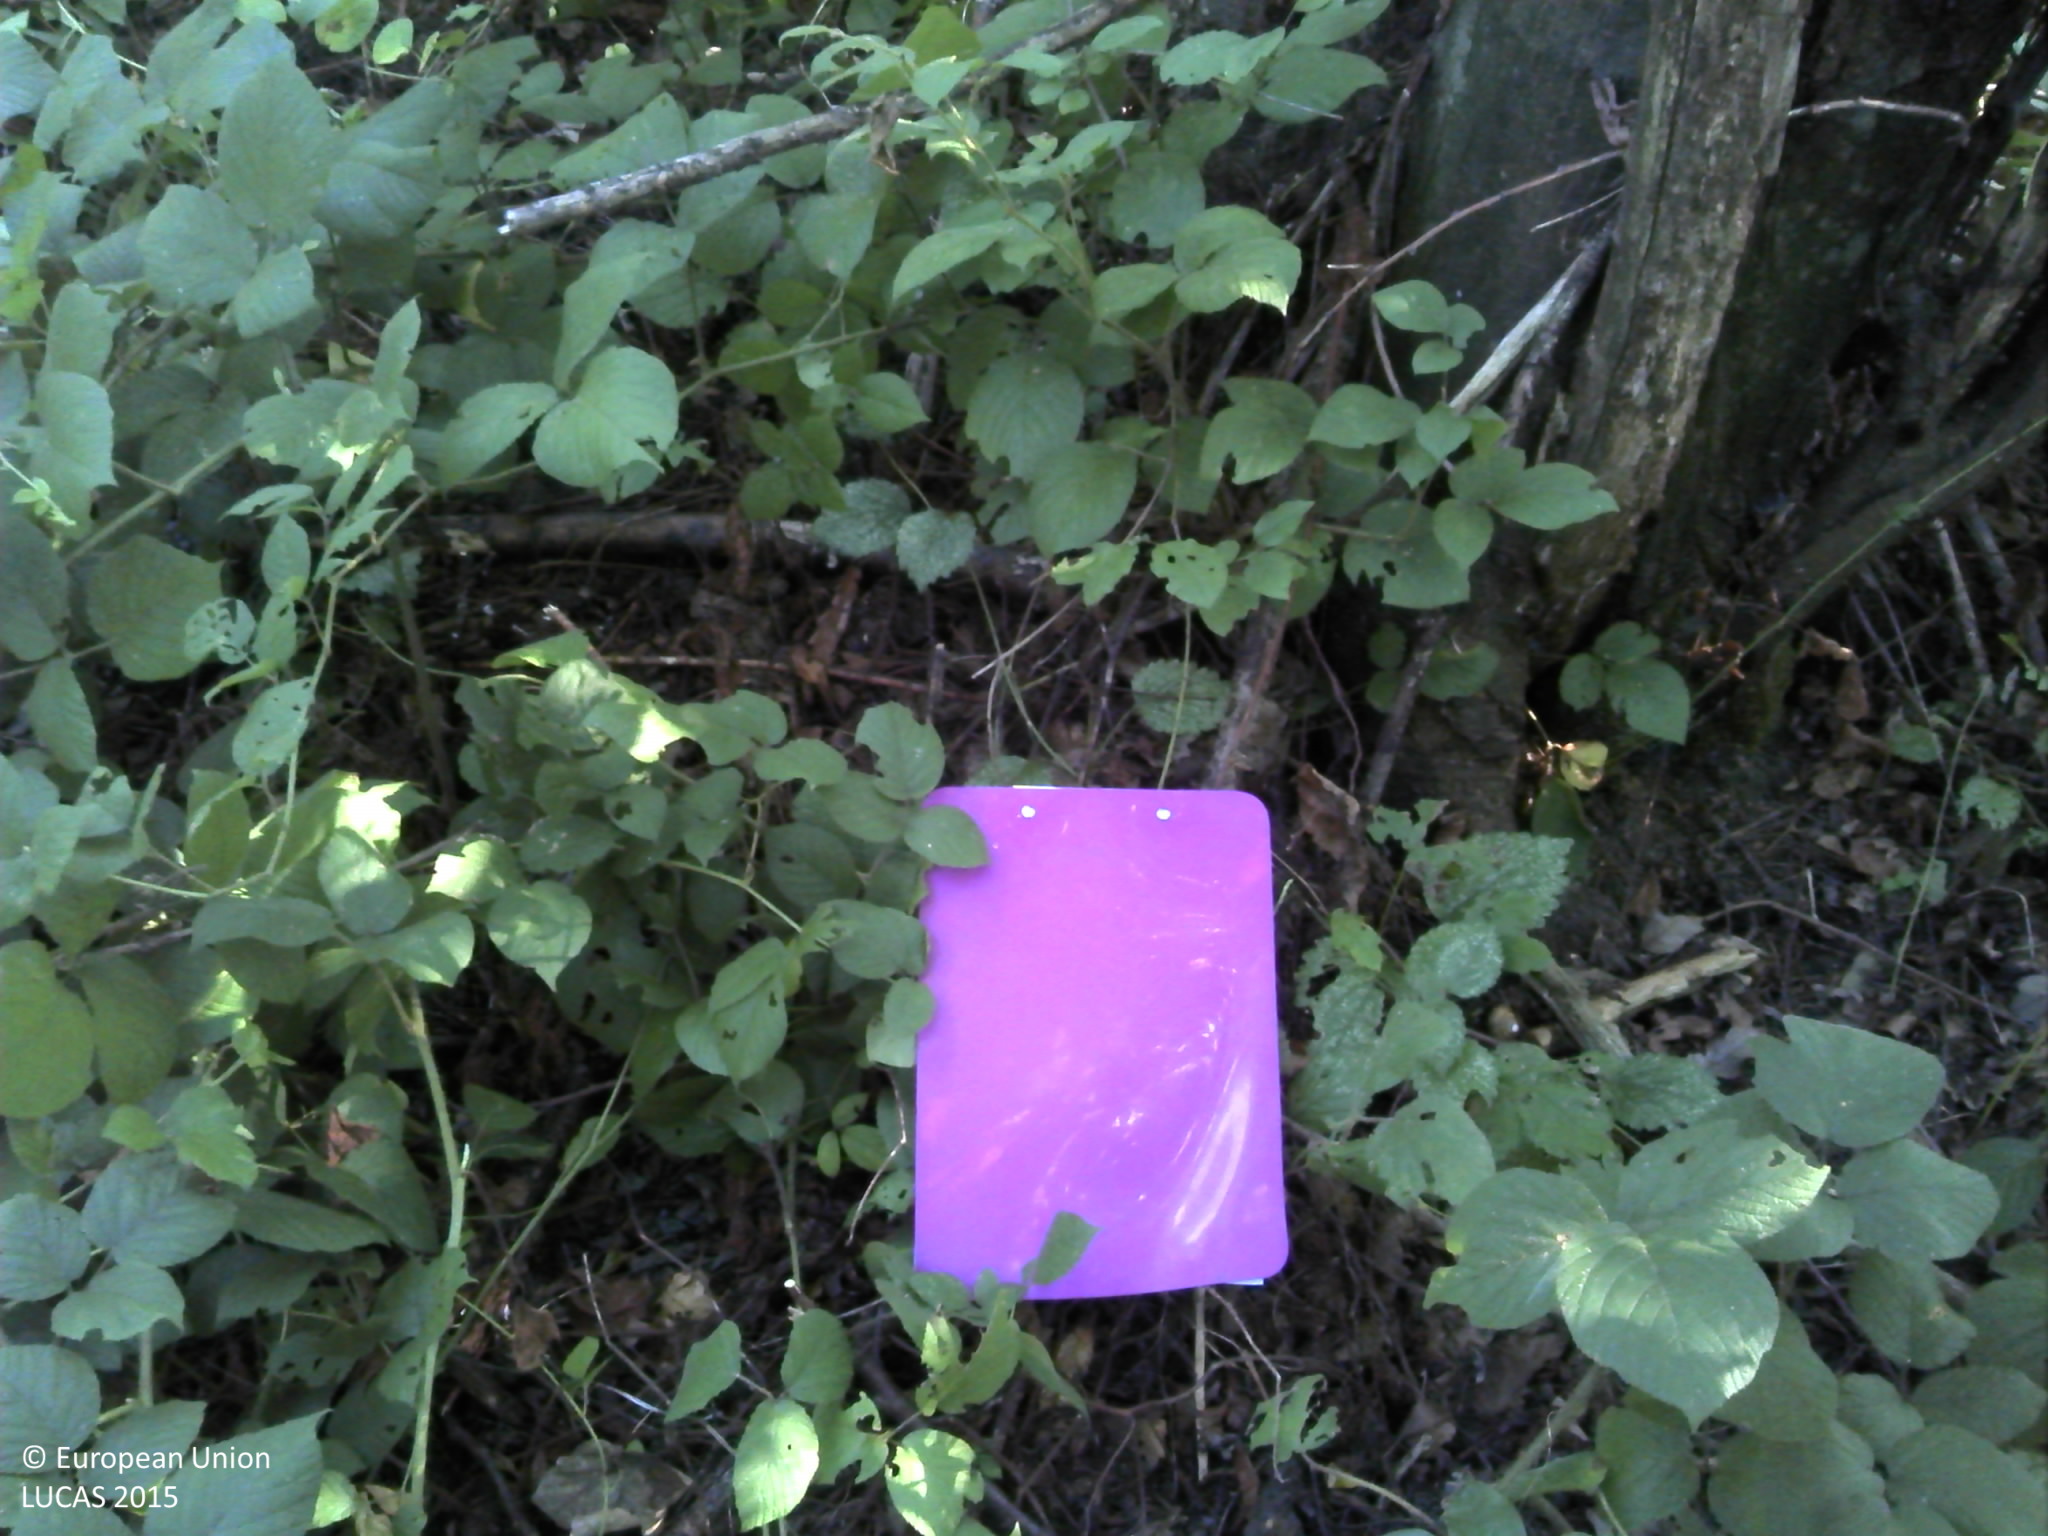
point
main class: Woodland
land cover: Broadleaved woodland
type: acidophilous oak and oak-birch forest
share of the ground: > 75 %
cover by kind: broadleaved forest trees 100 %
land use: Forestry
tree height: > 5 m
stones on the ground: < 10 %
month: August
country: HR
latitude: 45.3709
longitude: 16.2921
